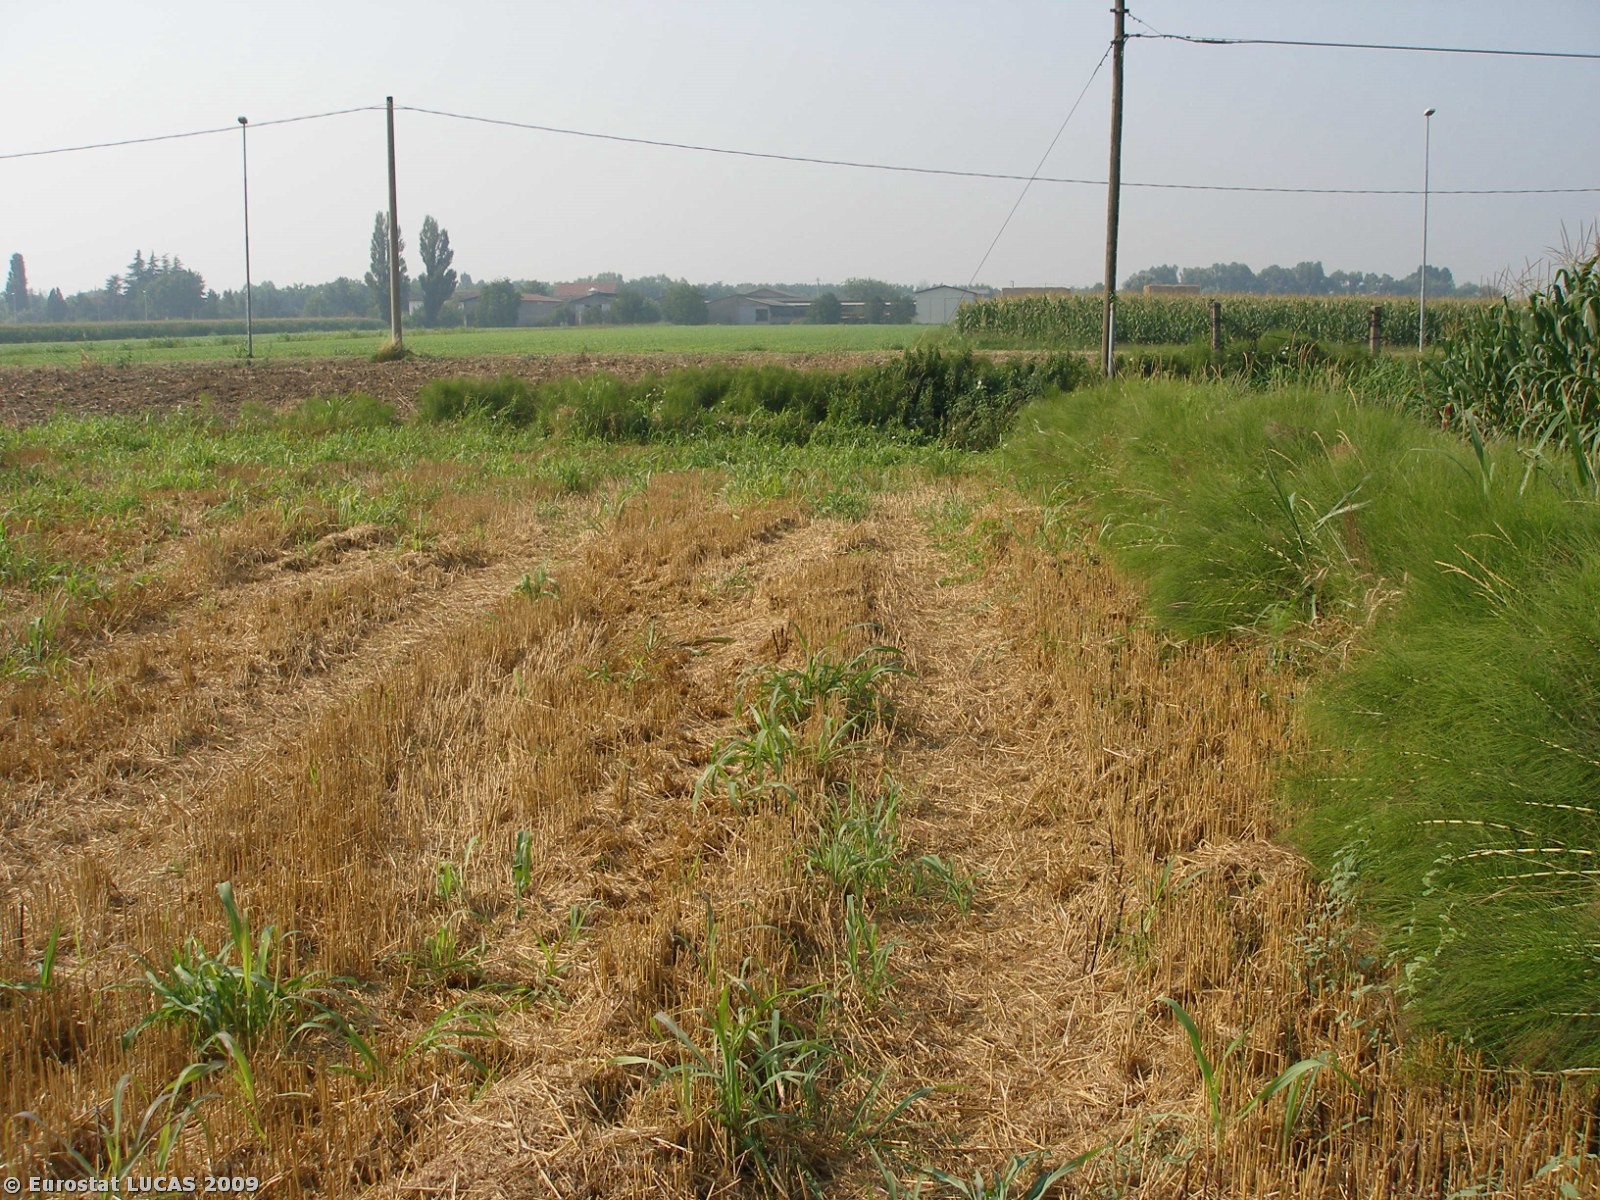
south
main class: Cropland
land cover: Maize
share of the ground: > 75 %
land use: Agriculture (excluding fallow land and kitchen gardens)
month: July
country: IT
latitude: 45.0034
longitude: 11.7348
